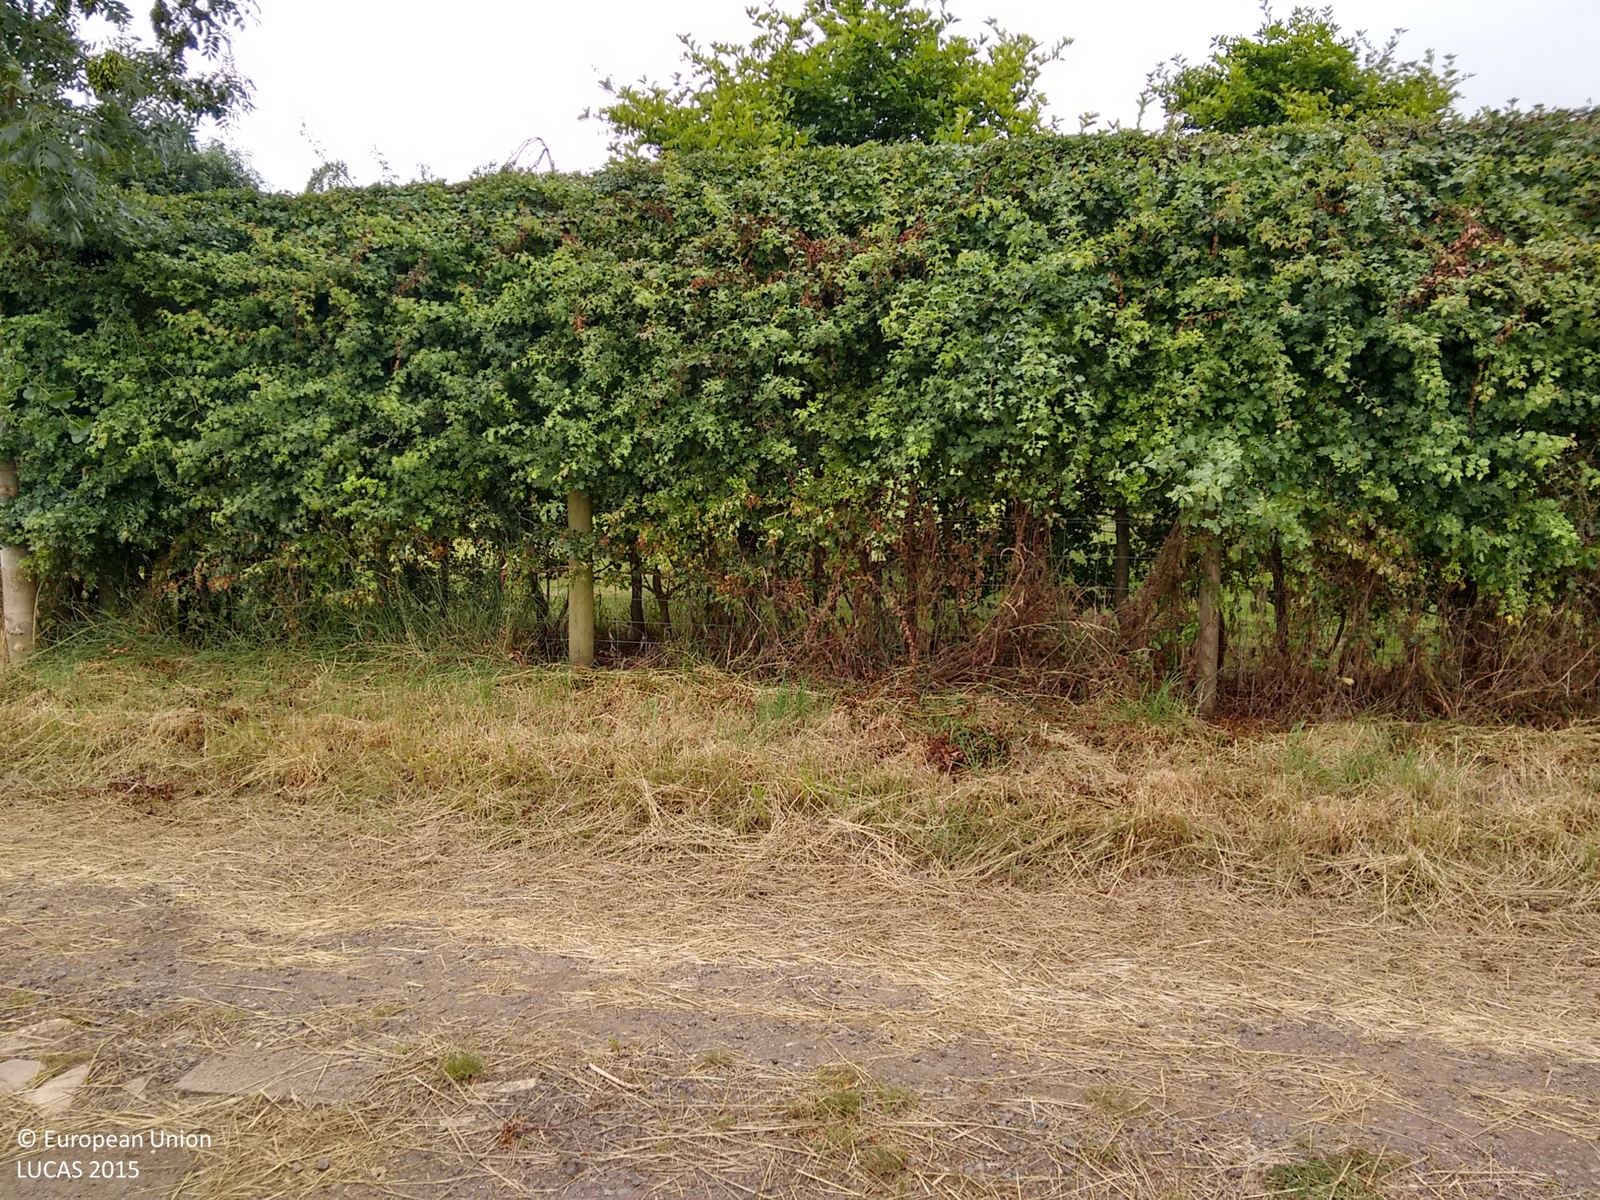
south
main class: Grassland
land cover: Grassland without tree/shrub cover
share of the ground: > 75 %
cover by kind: herbaceous plants 100 %
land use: Agriculture (excluding fallow land and kitchen gardens)
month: July
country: GB
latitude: 52.5266
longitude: -0.9062
